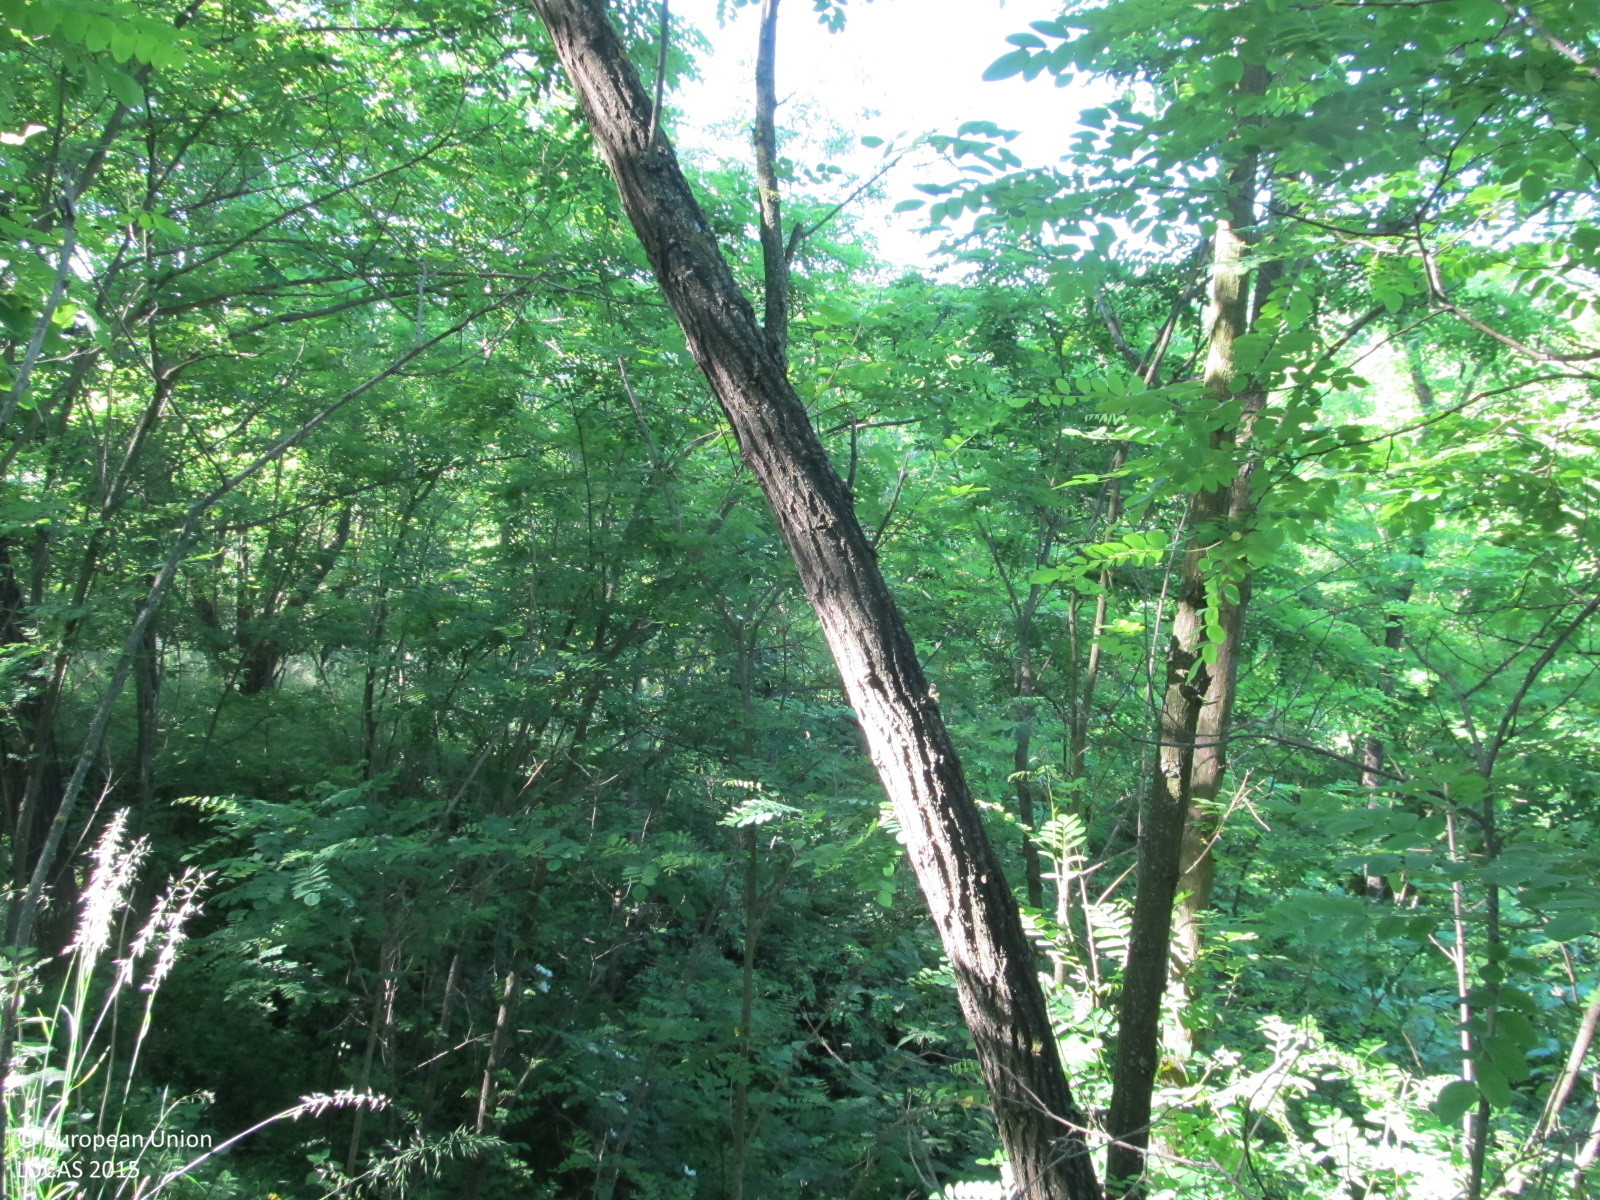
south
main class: Woodland
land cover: Broadleaved woodland
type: mesophytic deciduous forest
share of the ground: > 75 %
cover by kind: broadleaved forest trees 75 %, shrubs 15 %, herbaceous plants 10 %
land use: Semi-natural and natural areas not in use
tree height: > 5 m
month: June
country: AT
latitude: 48.4976
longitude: 15.9179
